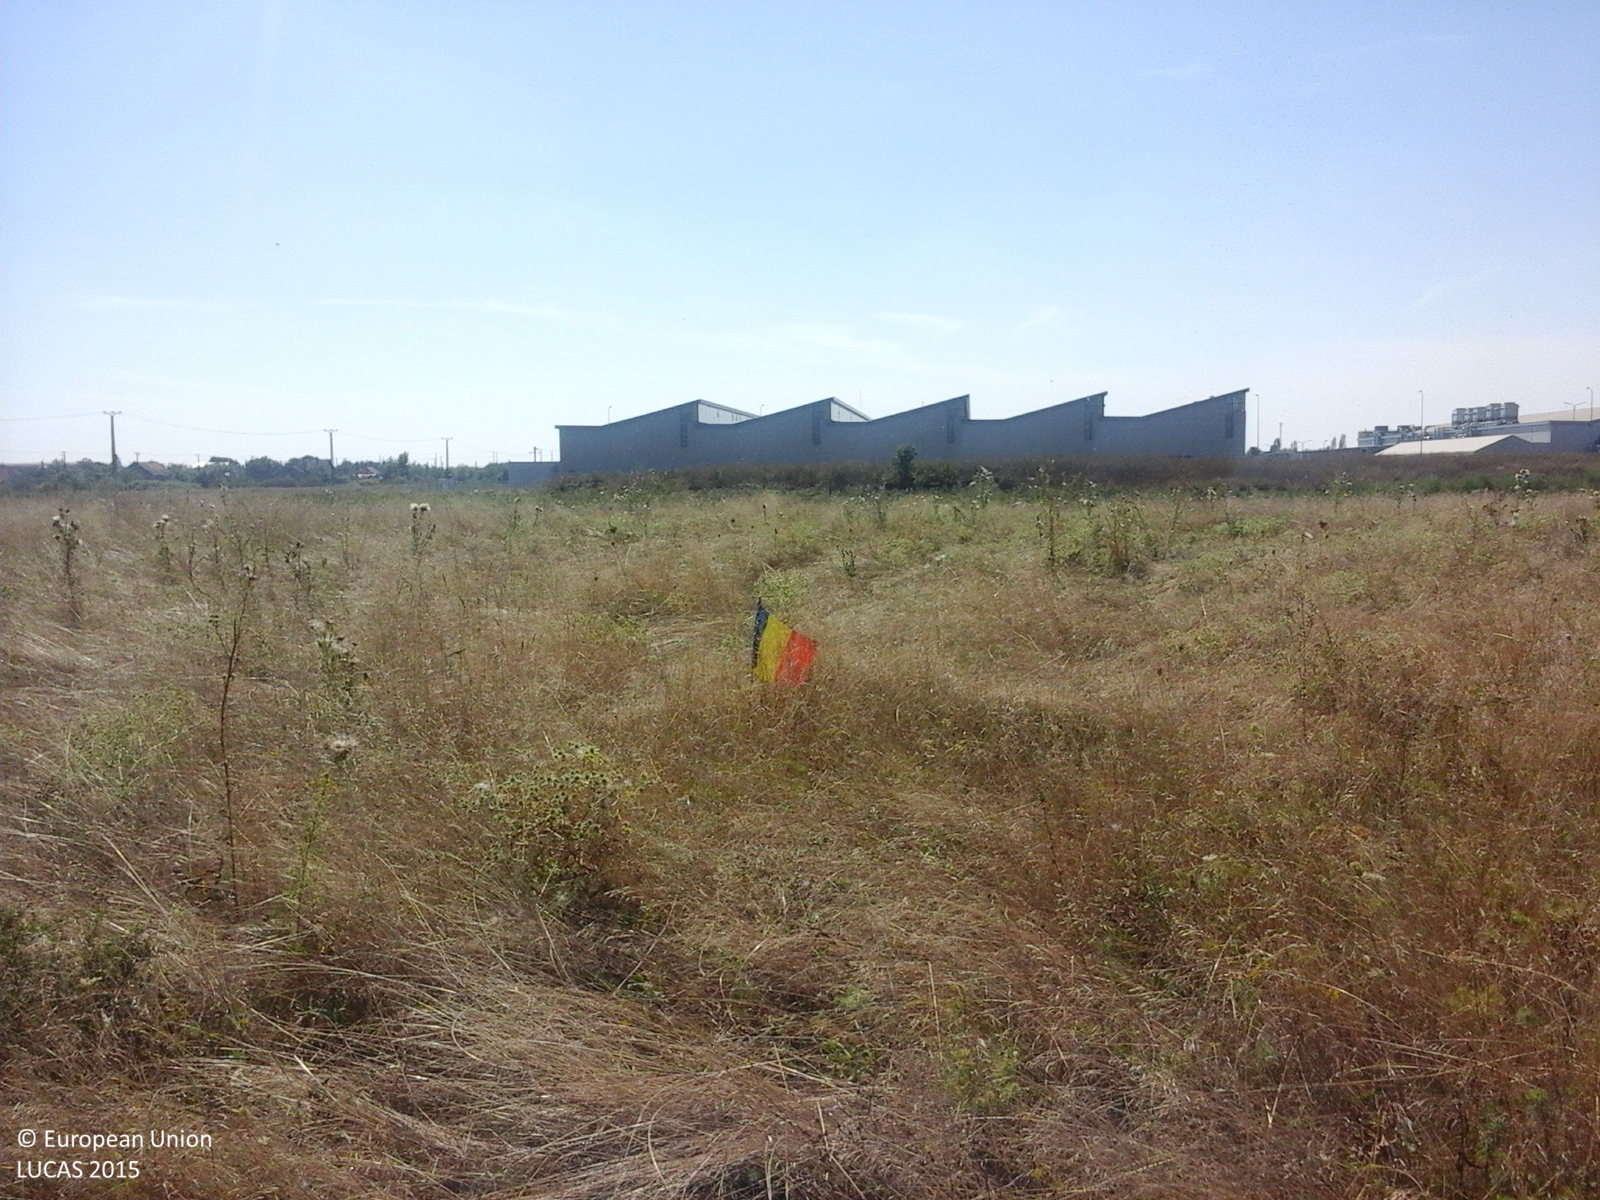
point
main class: Grassland
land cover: Spontaneously vegetated surfaces
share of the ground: > 75 %
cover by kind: herbaceous plants 100 %
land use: Fallow land
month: August
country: RO
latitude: 45.7278
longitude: 21.1703
